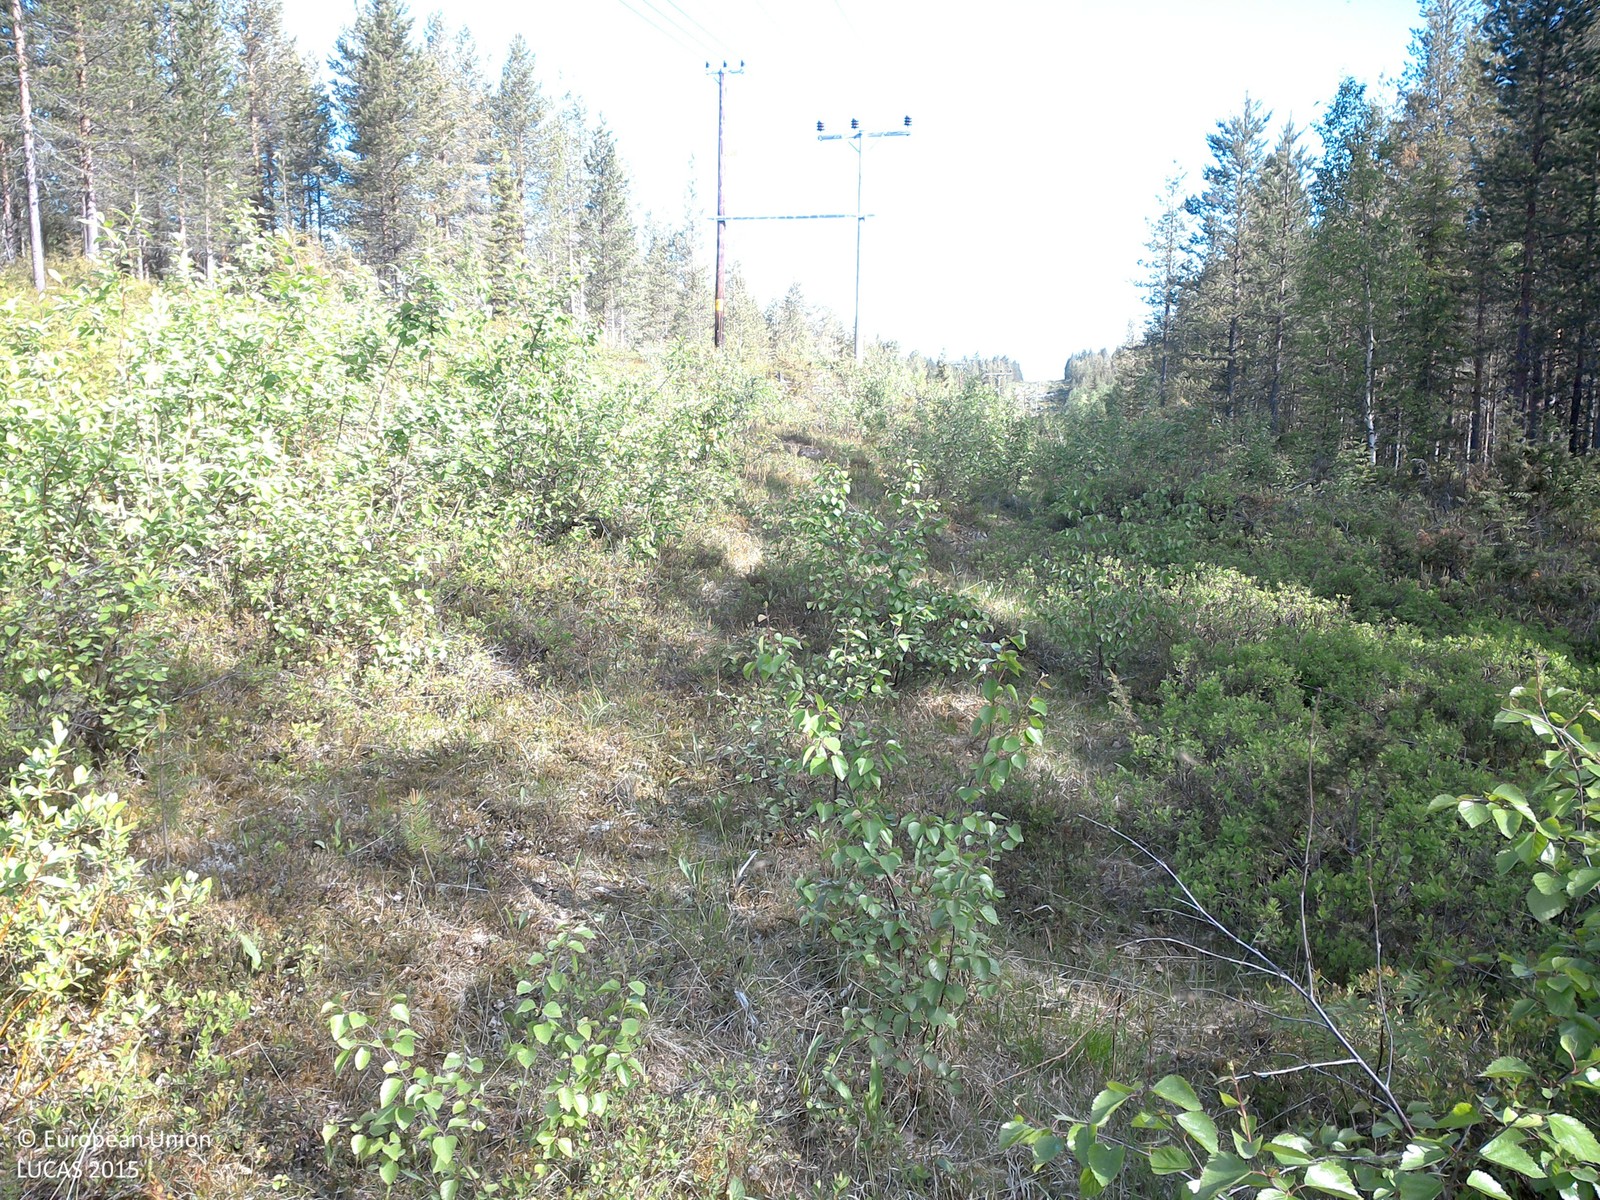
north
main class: Woodland
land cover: Broadleaved woodland
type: boreal forest
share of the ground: 10 - 25 %
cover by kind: shrubs 70 %, broadleaved forest trees 15 %, lichens and mosses 10 %, herbaceous plants 5 %
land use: Community services
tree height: < 5 m
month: June
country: SE
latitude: 66.8544
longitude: 23.0364
